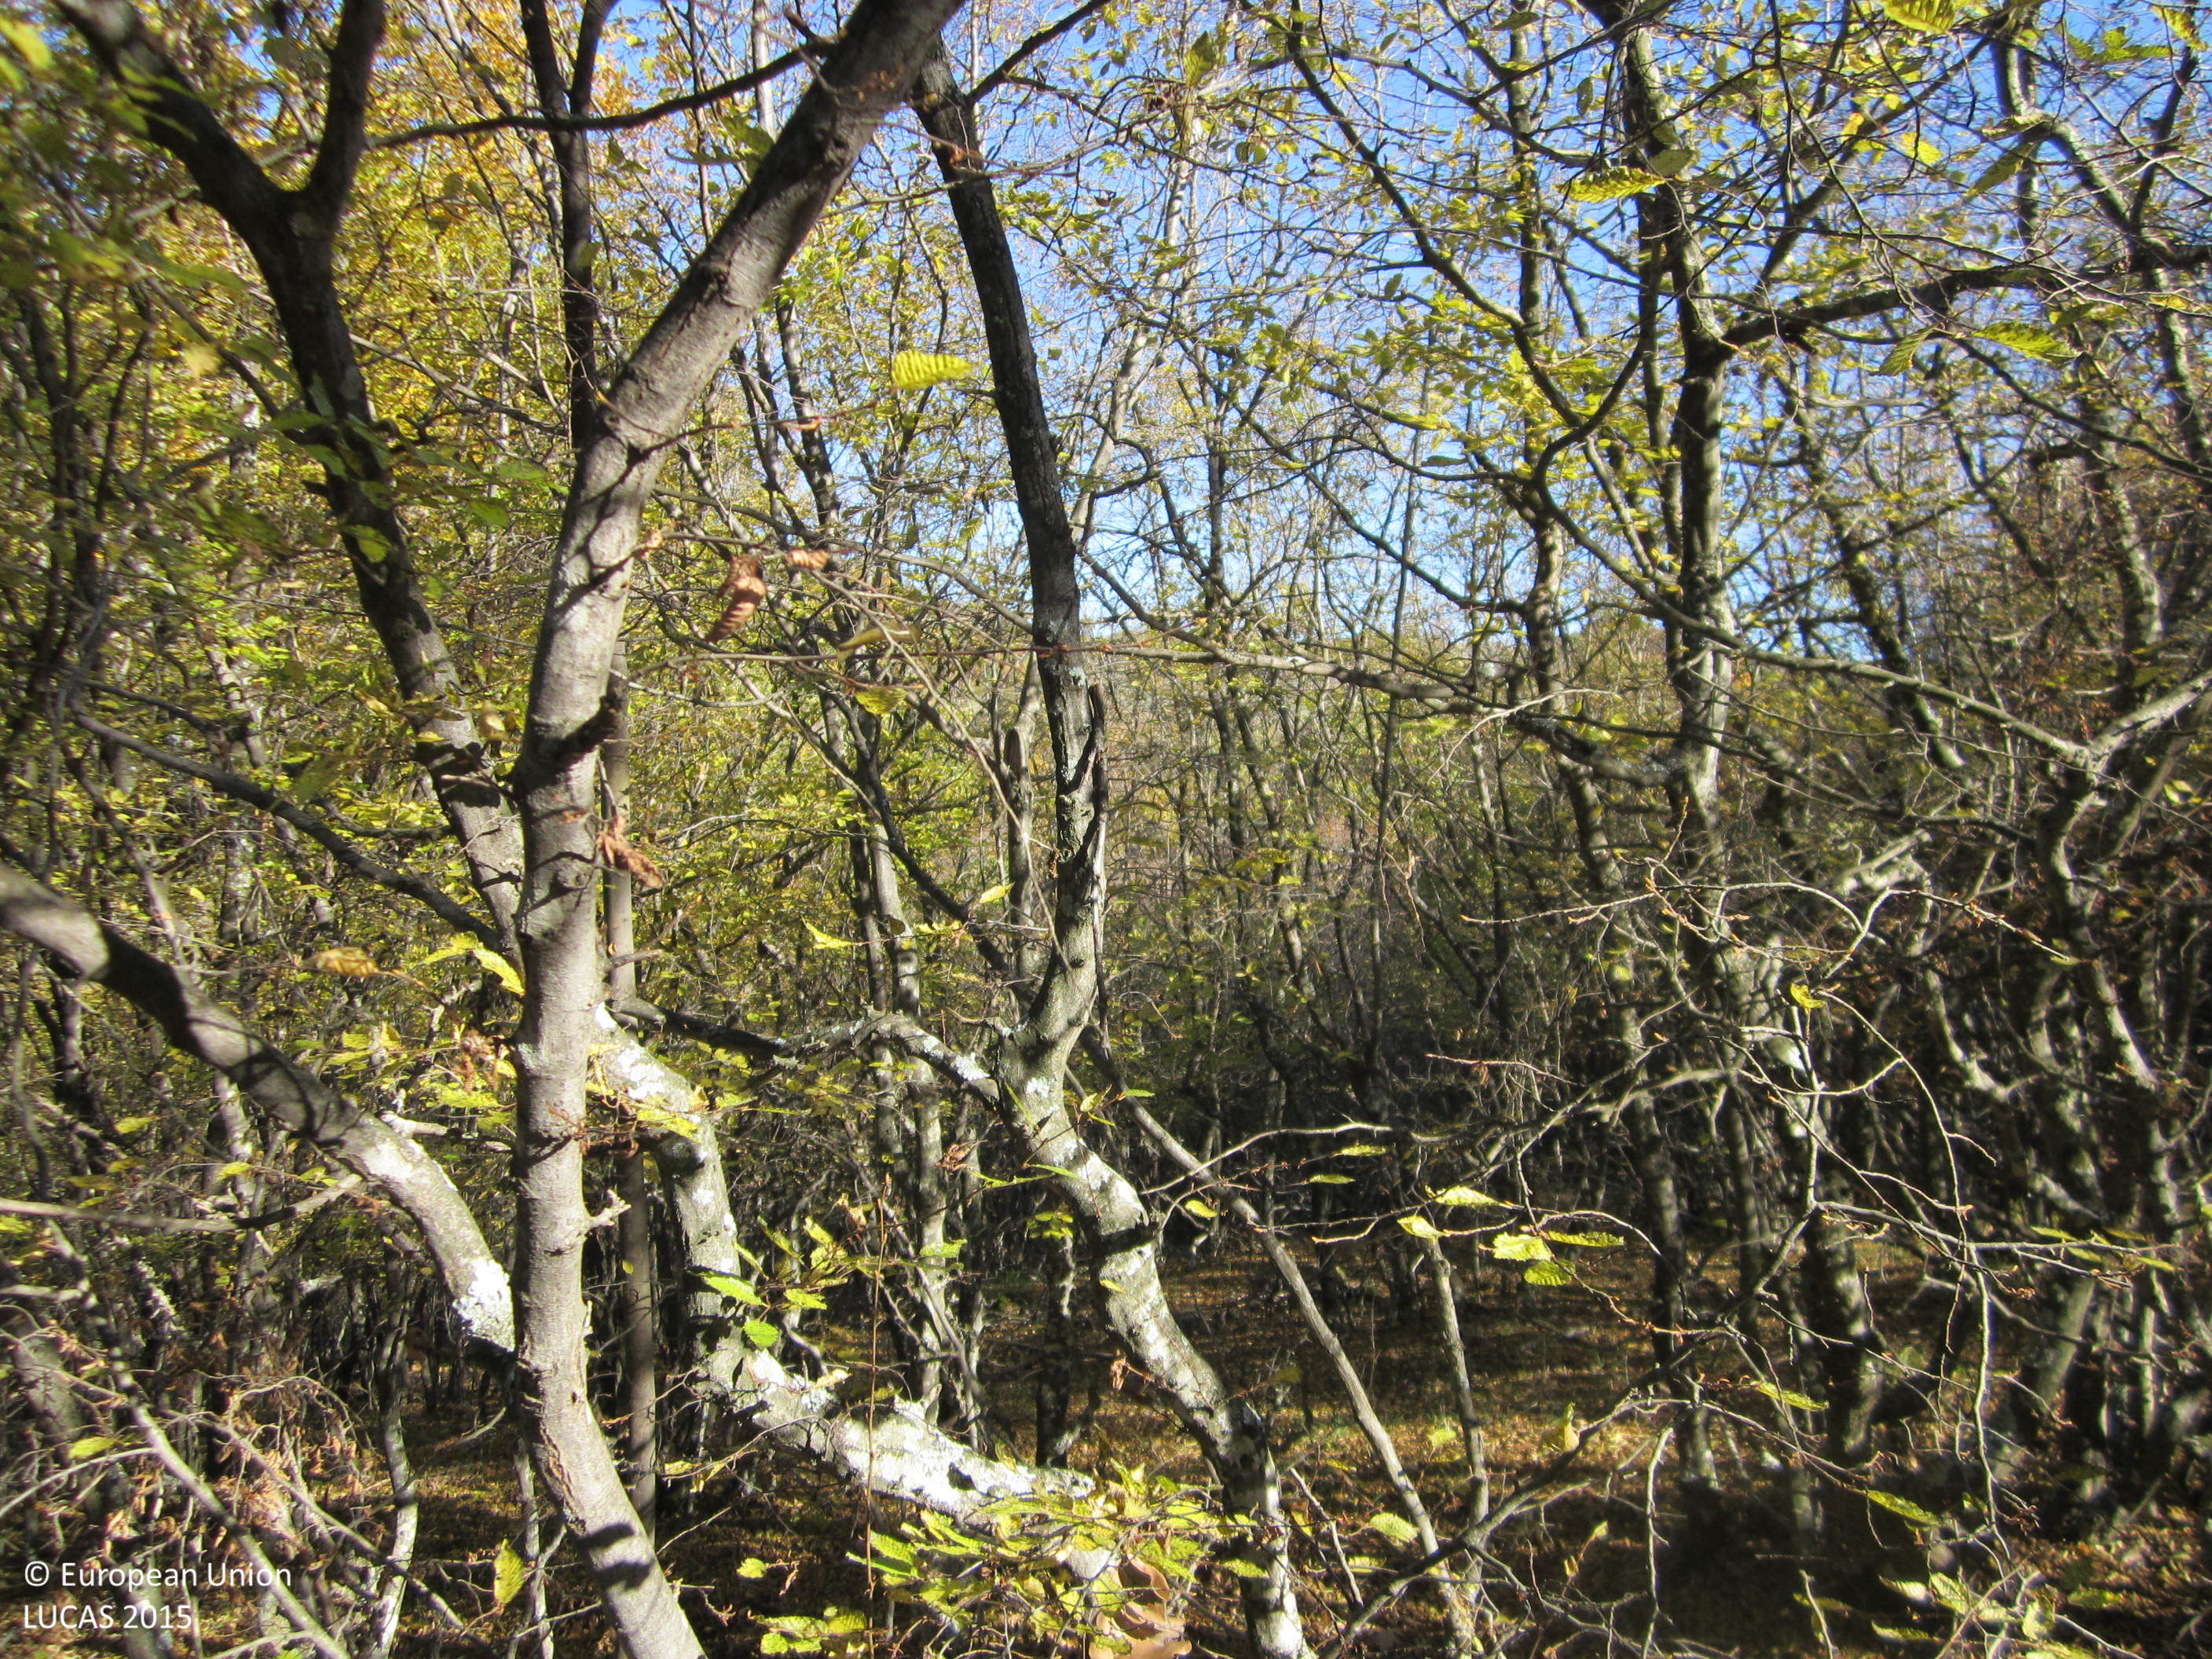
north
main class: Woodland
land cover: Broadleaved woodland
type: mesophytic deciduous forest
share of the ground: > 75 %
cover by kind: broadleaved forest trees 80 %, herbaceous plants 15 %, shrubs 5 %
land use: Forestry
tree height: > 5 m
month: November
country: BG
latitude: 41.4878
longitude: 25.7404
